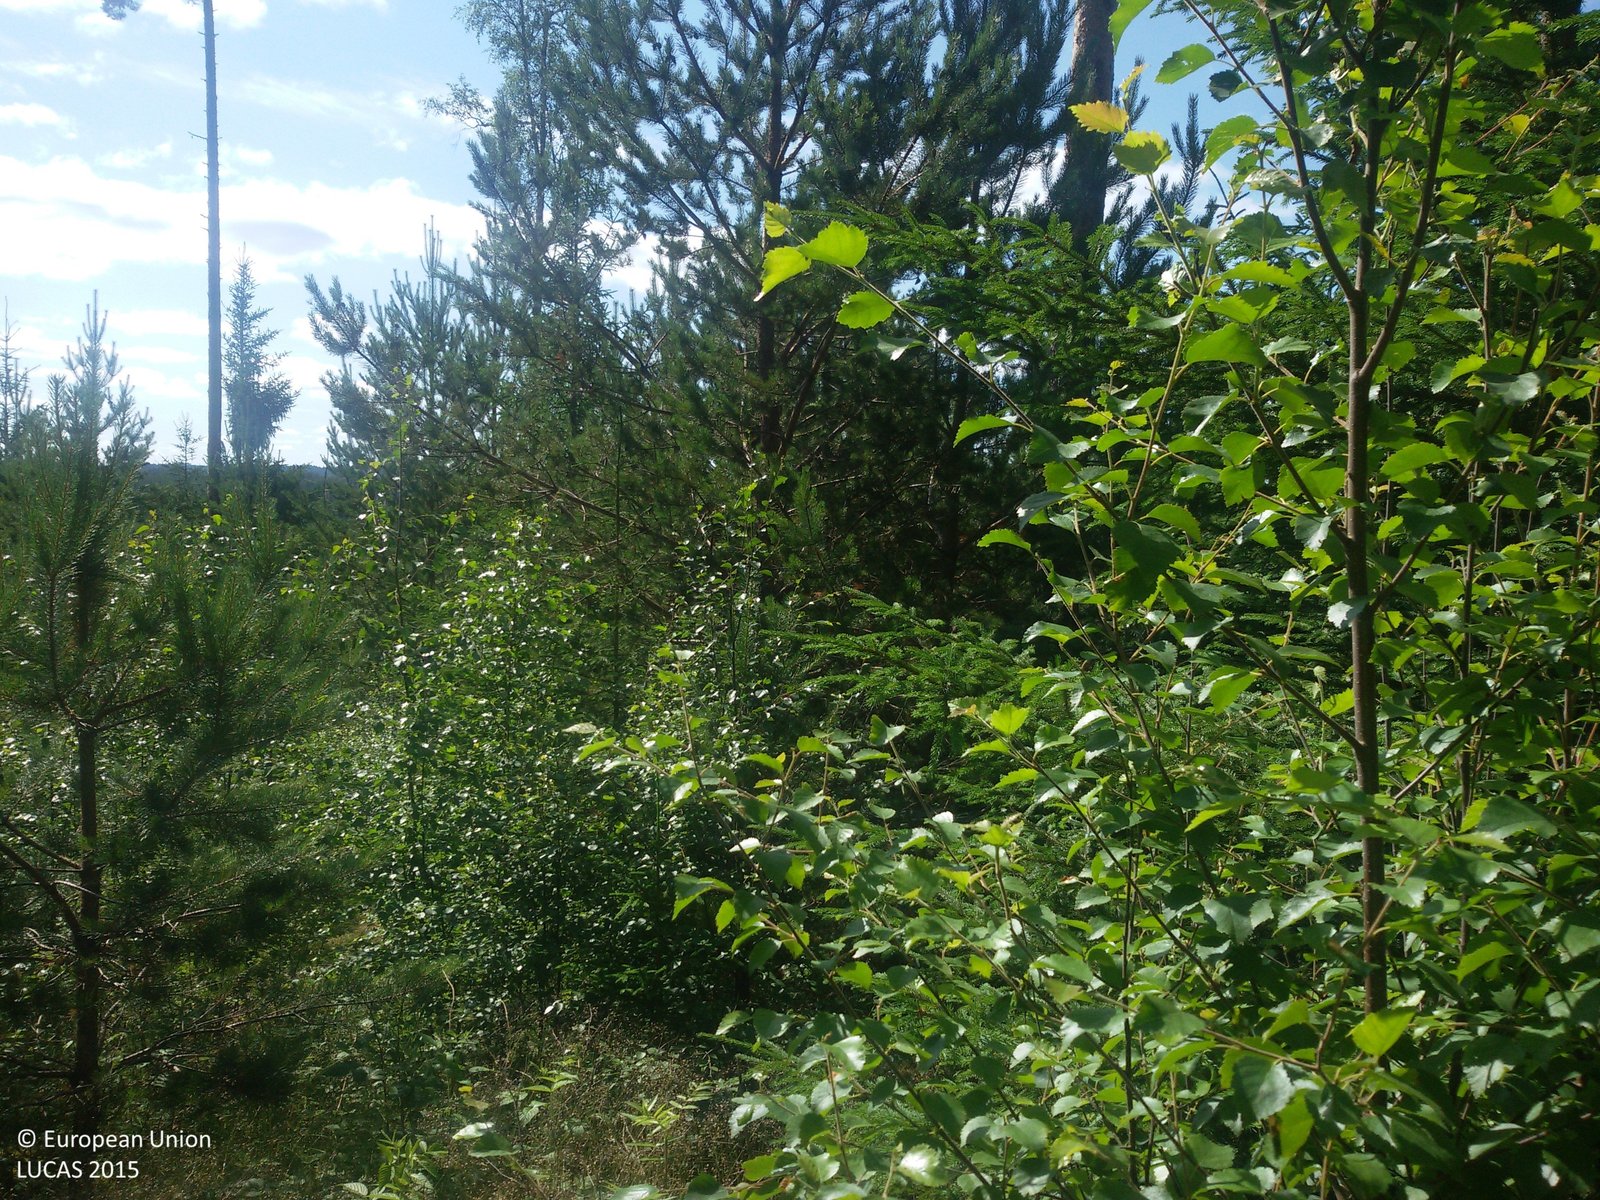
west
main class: Woodland
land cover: Pine dominated mixed woodland
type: boreal forest
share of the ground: > 75 %
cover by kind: coniferous forest trees 70 %, broadleaved forest trees 30 %
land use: Forestry
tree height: < 5 m
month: July
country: SE
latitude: 60.4726
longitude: 14.9538
